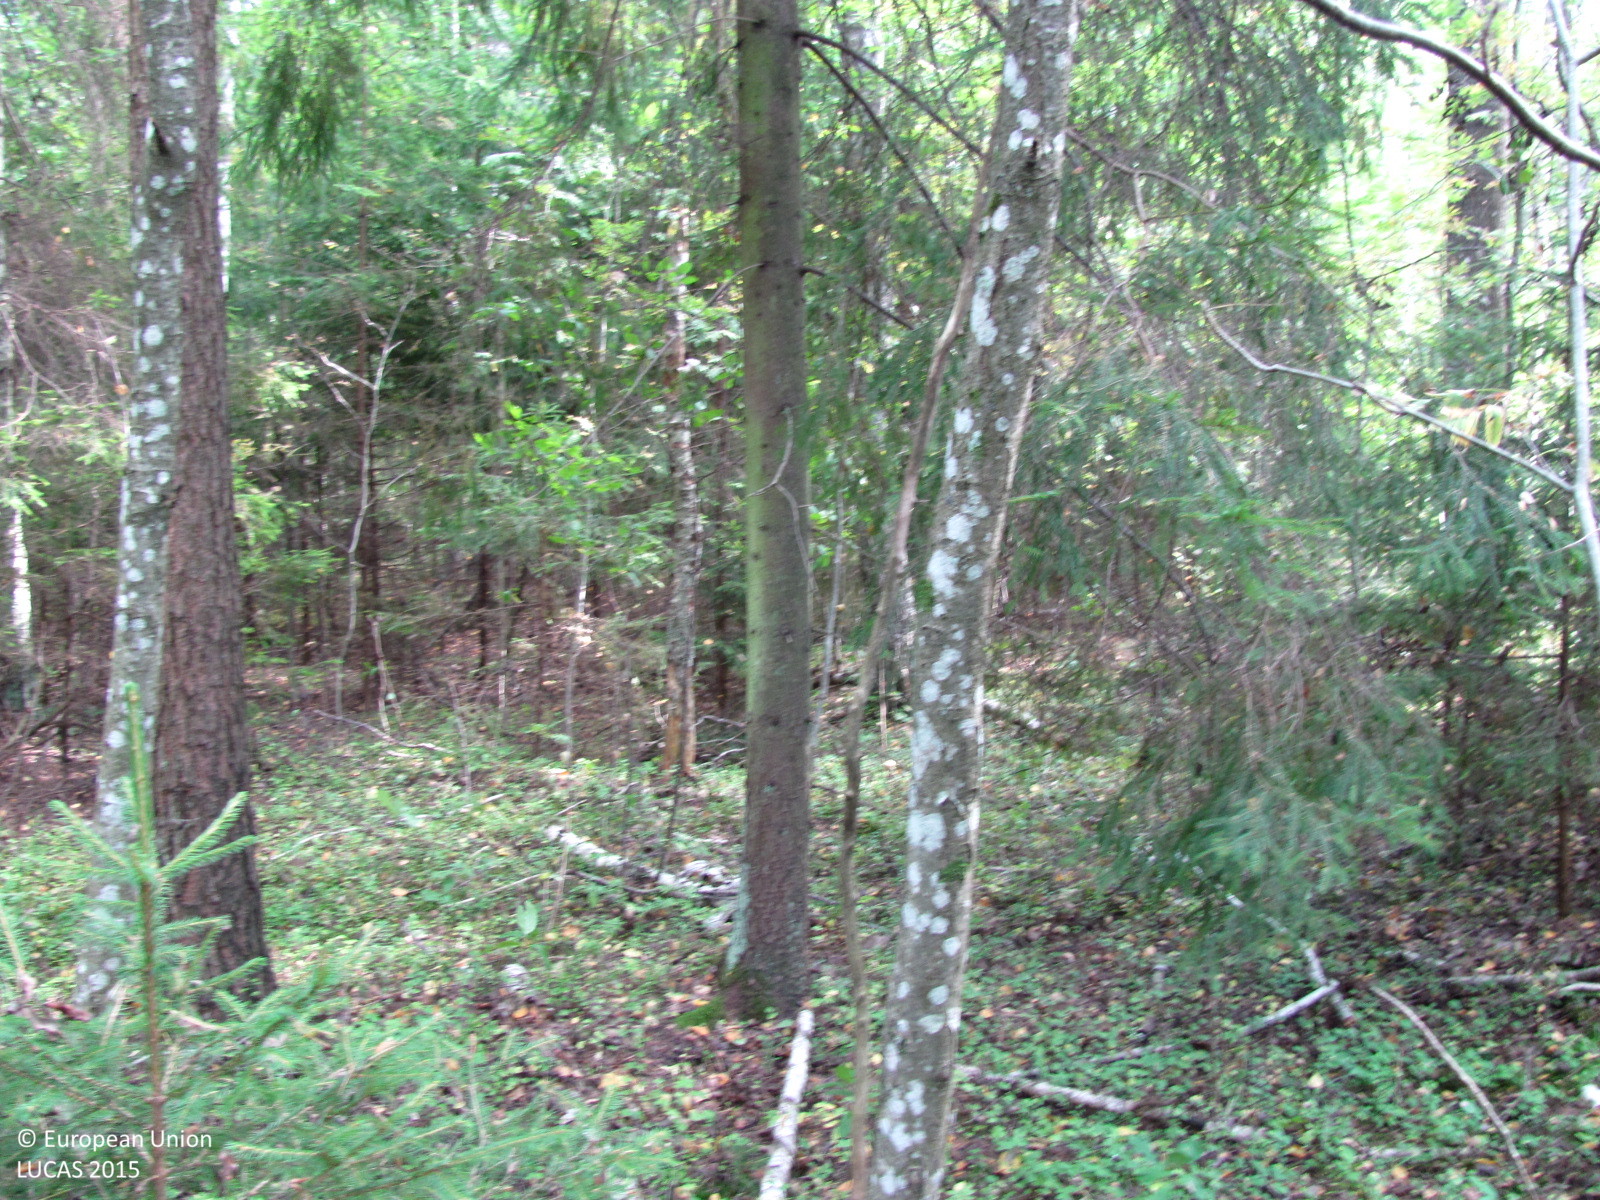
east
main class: Woodland
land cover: Other mixed woodland
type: hemiboreal forest and nemoral coniferous forest and mixed broadleaved-coniferous forest
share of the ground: > 75 %
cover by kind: coniferous forest trees 40 %, broadleaved forest trees 40 %, herbaceous plants 10 %, lichens and mosses 10 %
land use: Forestry
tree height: > 5 m
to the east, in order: Other mixed woodland; Ditches and canals; Spruce dominated mixed woodland; Ditches and canals; Spruce dominated mixed woodland
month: September
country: LV
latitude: 56.6615
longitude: 25.1027
